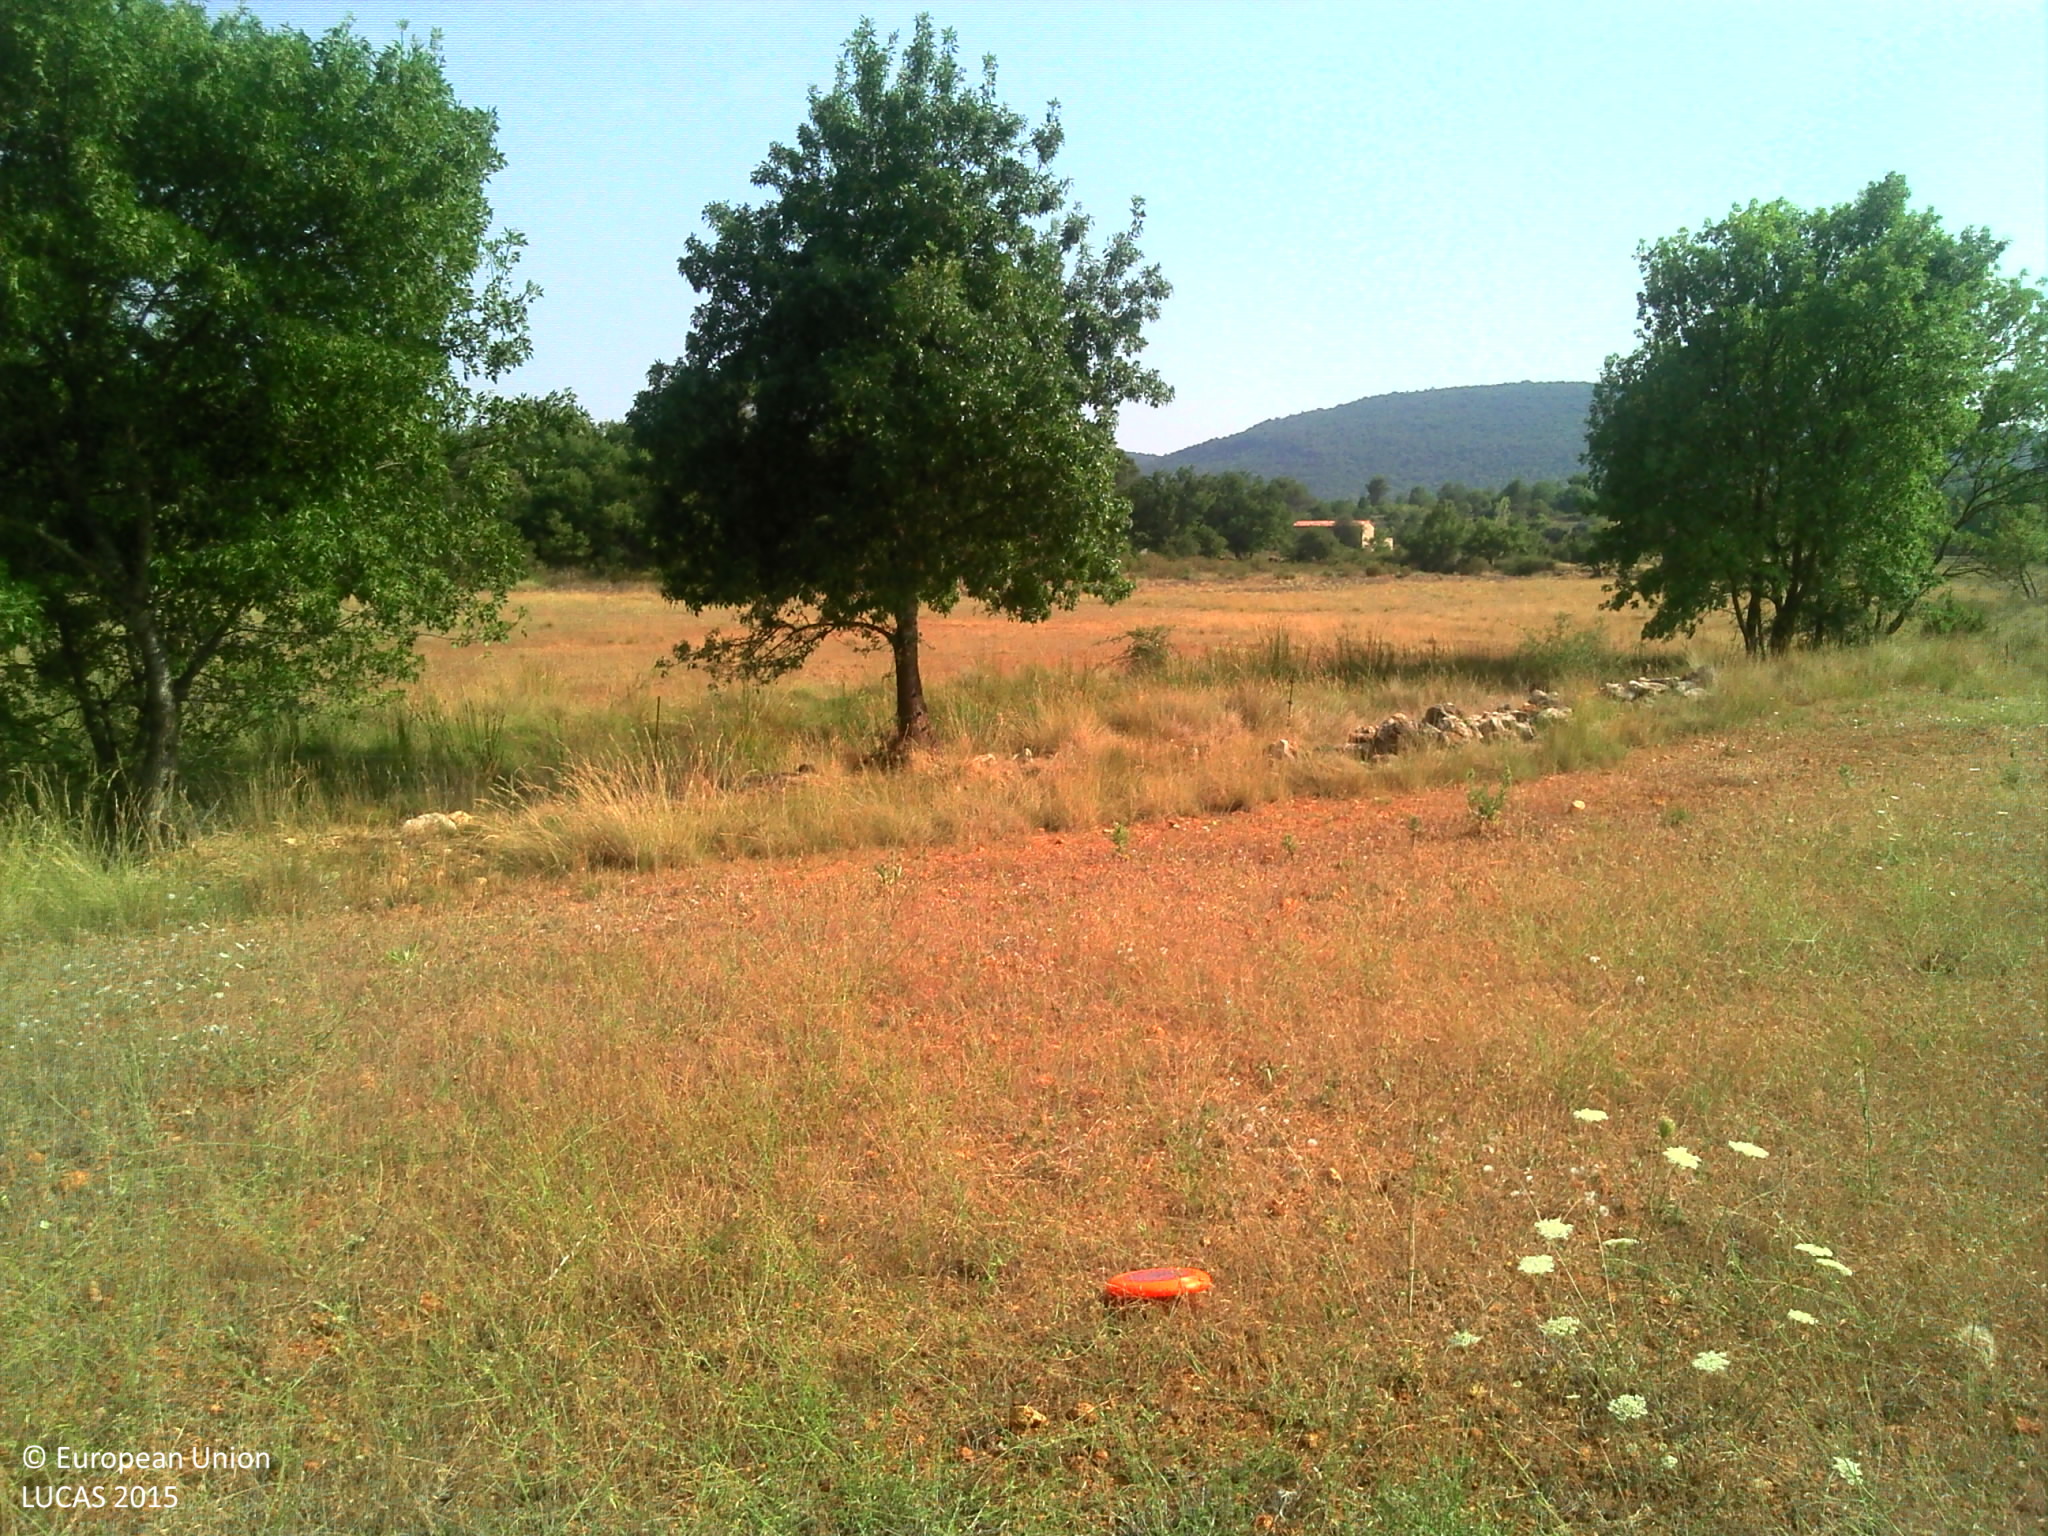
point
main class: Cropland
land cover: Temporary grasslands
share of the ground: > 75 %
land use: Agriculture (excluding fallow land and kitchen gardens)
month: August
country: FR
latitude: 43.6183
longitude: 6.3529
